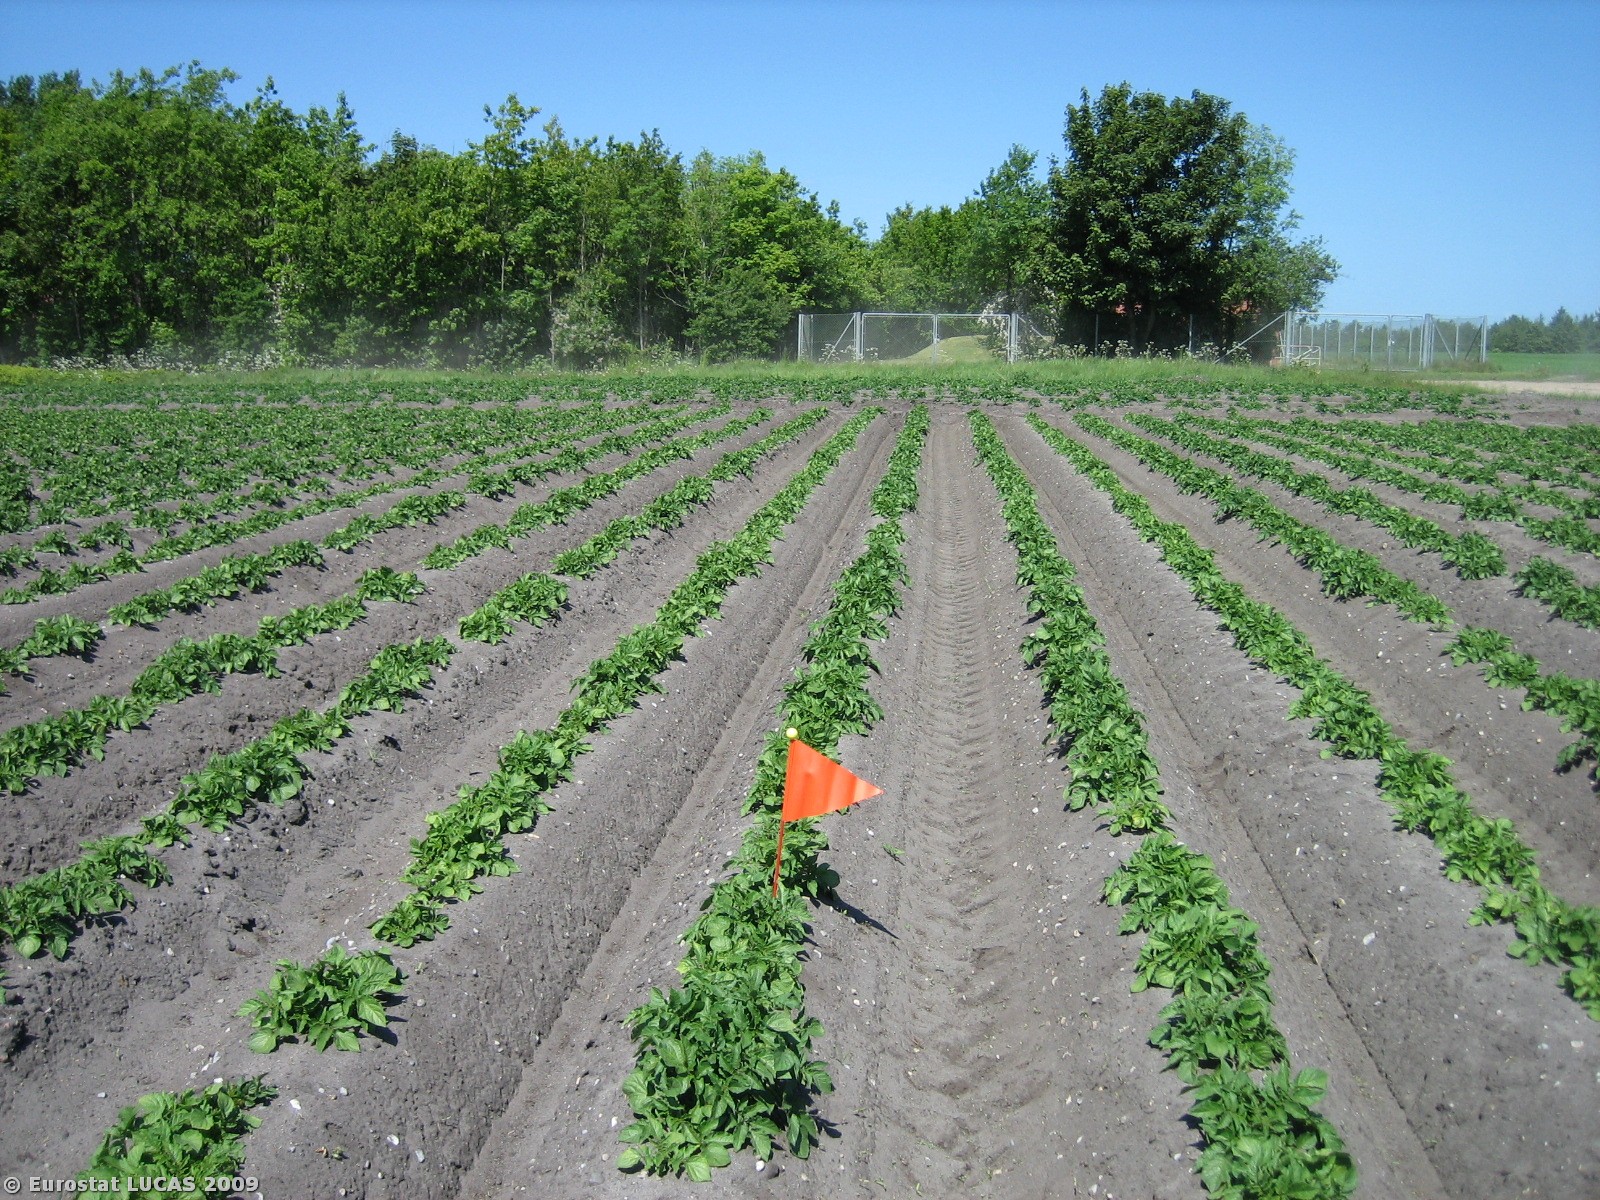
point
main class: Cropland
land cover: Potatoes
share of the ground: 10 - 25 %
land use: Agriculture (excluding fallow land and kitchen gardens)
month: May
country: DK
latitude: 55.9128
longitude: 8.8333
